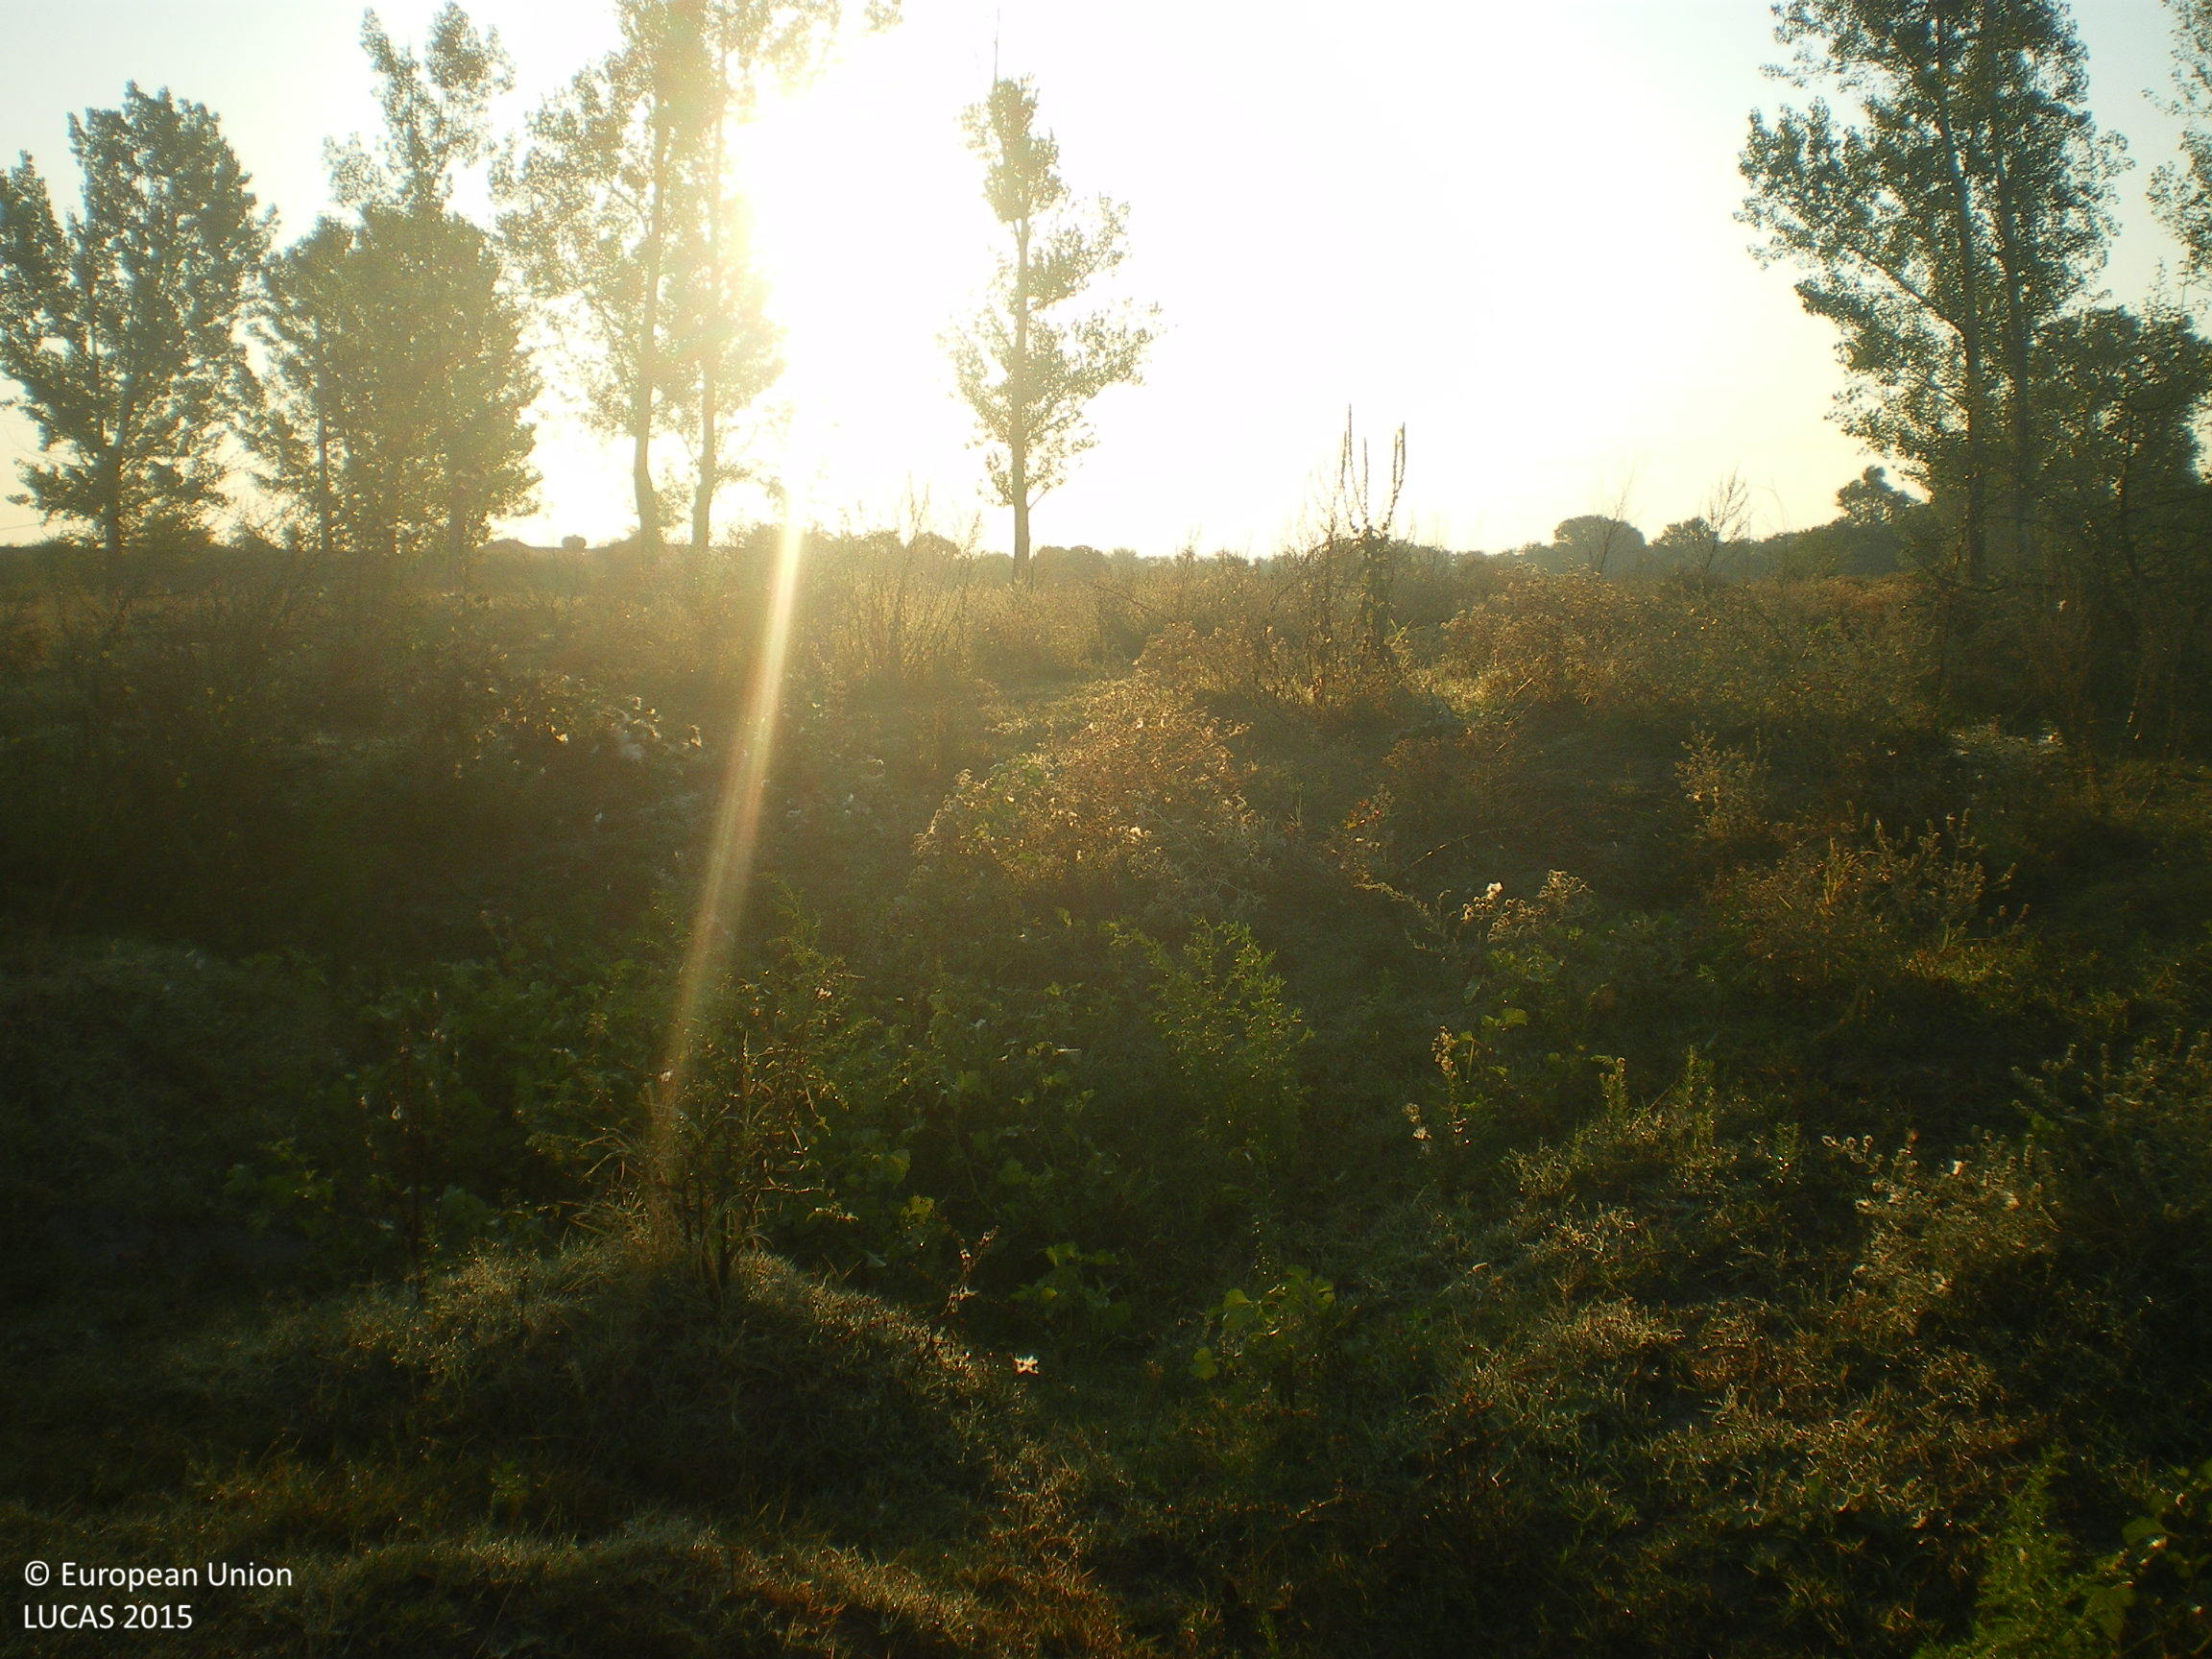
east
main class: Grassland
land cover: Grassland with sparse tree/shrub cover
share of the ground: > 75 %
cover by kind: herbaceous plants 90 %, broadleaved forest trees 5 %, shrubs 5 %
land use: Agriculture (excluding fallow land and kitchen gardens)
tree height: > 5 m
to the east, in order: Grassland with sparse tree/shrub cover; Grassland without tree/shrub cover; Grassland with sparse tree/shrub cover; Grassland without tree/shrub cover; Tracks; Grassland without tree/shrub cover; Other bare soil; Grassland without tree/shrub cover; Grassland with sparse tree/shrub cover
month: August
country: BG
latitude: 42.0380
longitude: 25.8605
